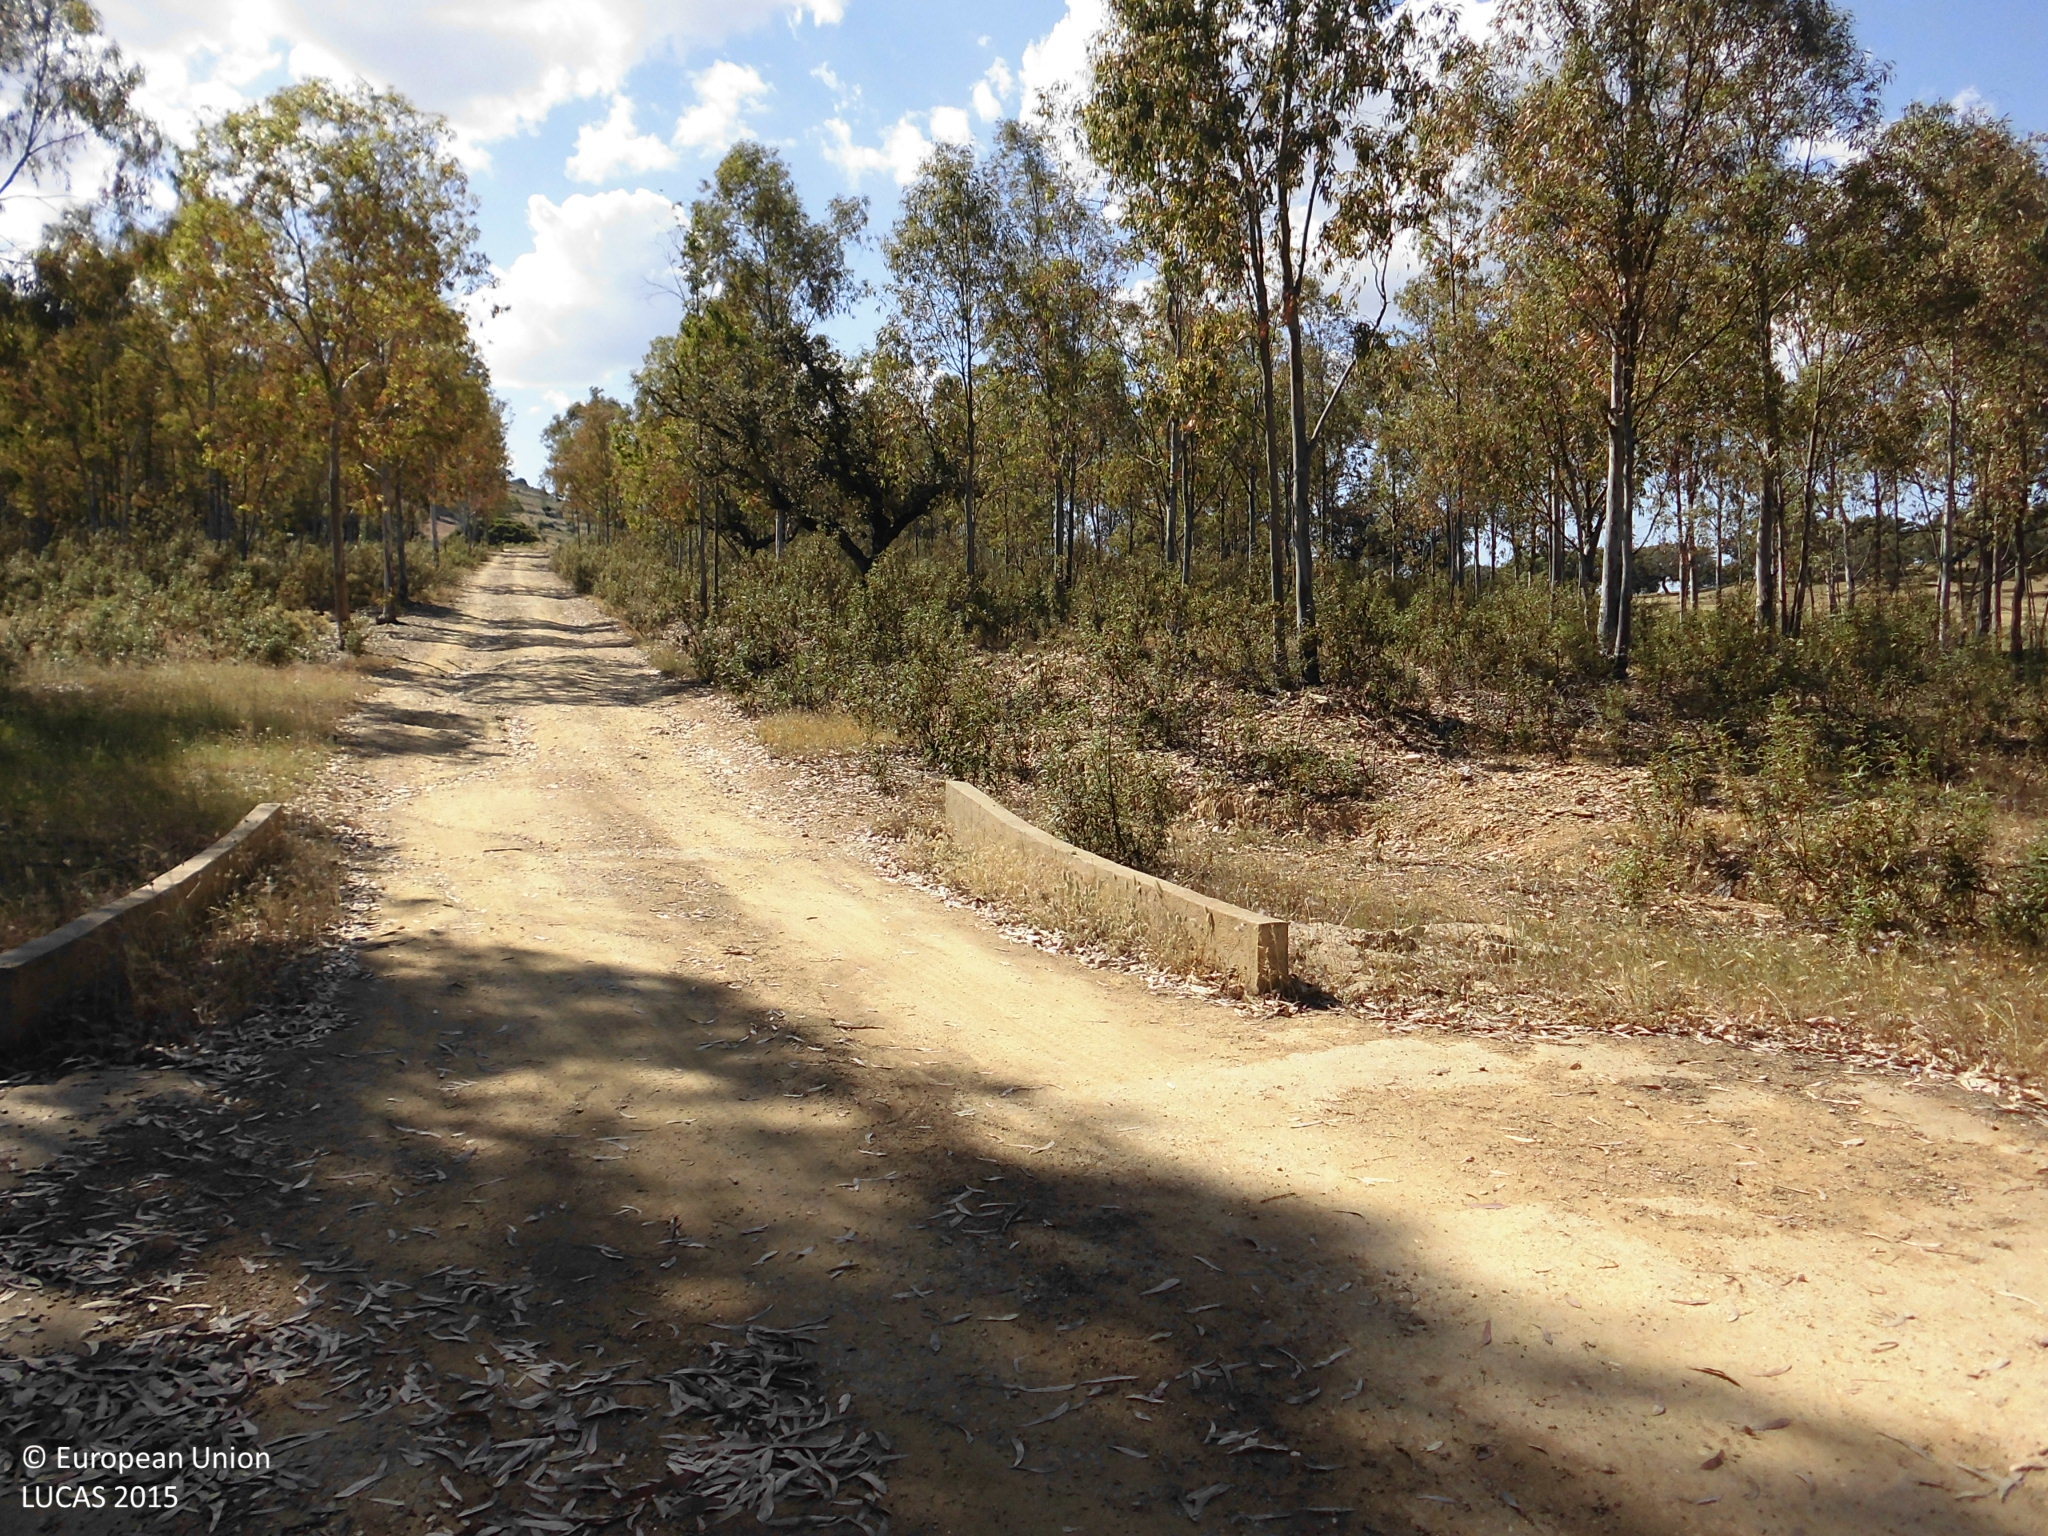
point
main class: Grassland
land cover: Grassland with sparse tree/shrub cover
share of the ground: > 75 %
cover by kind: herbaceous plants 85 %, consolidated bare surface 10 %, broadleaved forest trees 5 %
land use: Agriculture (excluding fallow land and kitchen gardens)
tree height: > 5 m
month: May
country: ES
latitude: 39.9694
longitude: -6.7927
